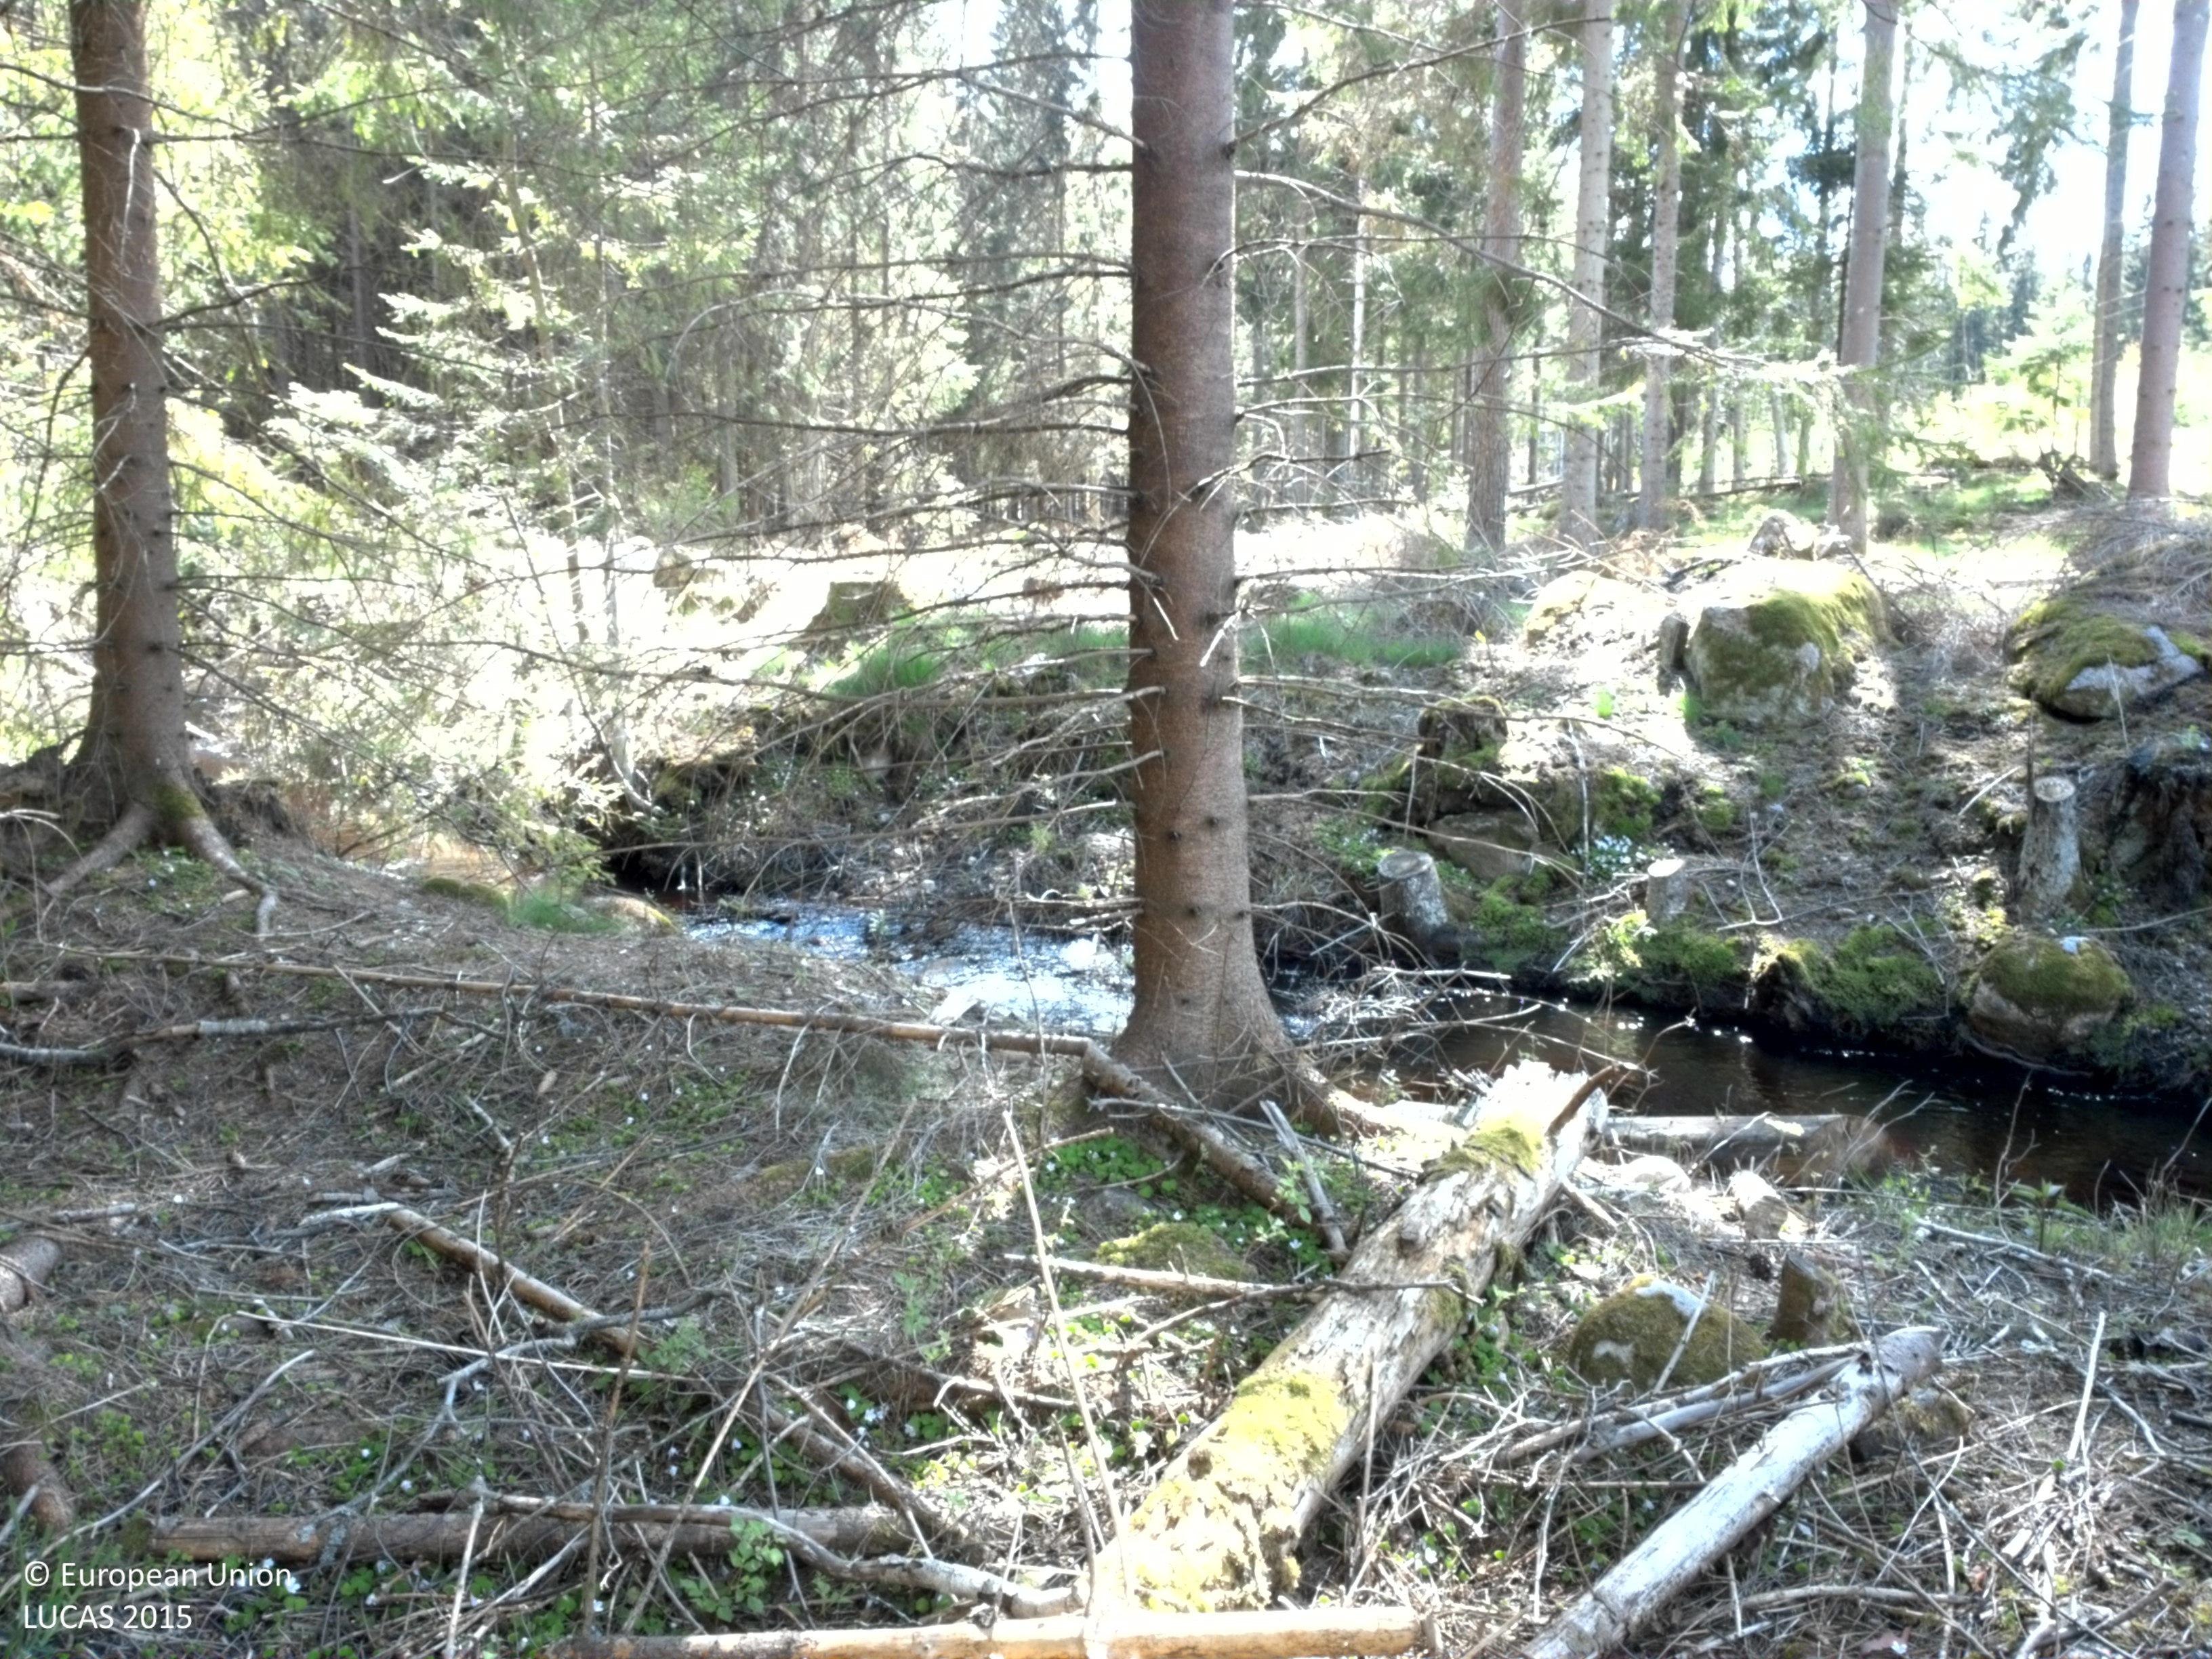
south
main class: Woodland
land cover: Spruce dominated mixed woodland
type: boreal forest
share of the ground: > 75 %
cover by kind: coniferous forest trees 75 %, broadleaved forest trees 25 %
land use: Forestry
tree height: > 5 m
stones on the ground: < 10 %
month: May
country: SE
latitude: 56.4373
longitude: 15.3347
